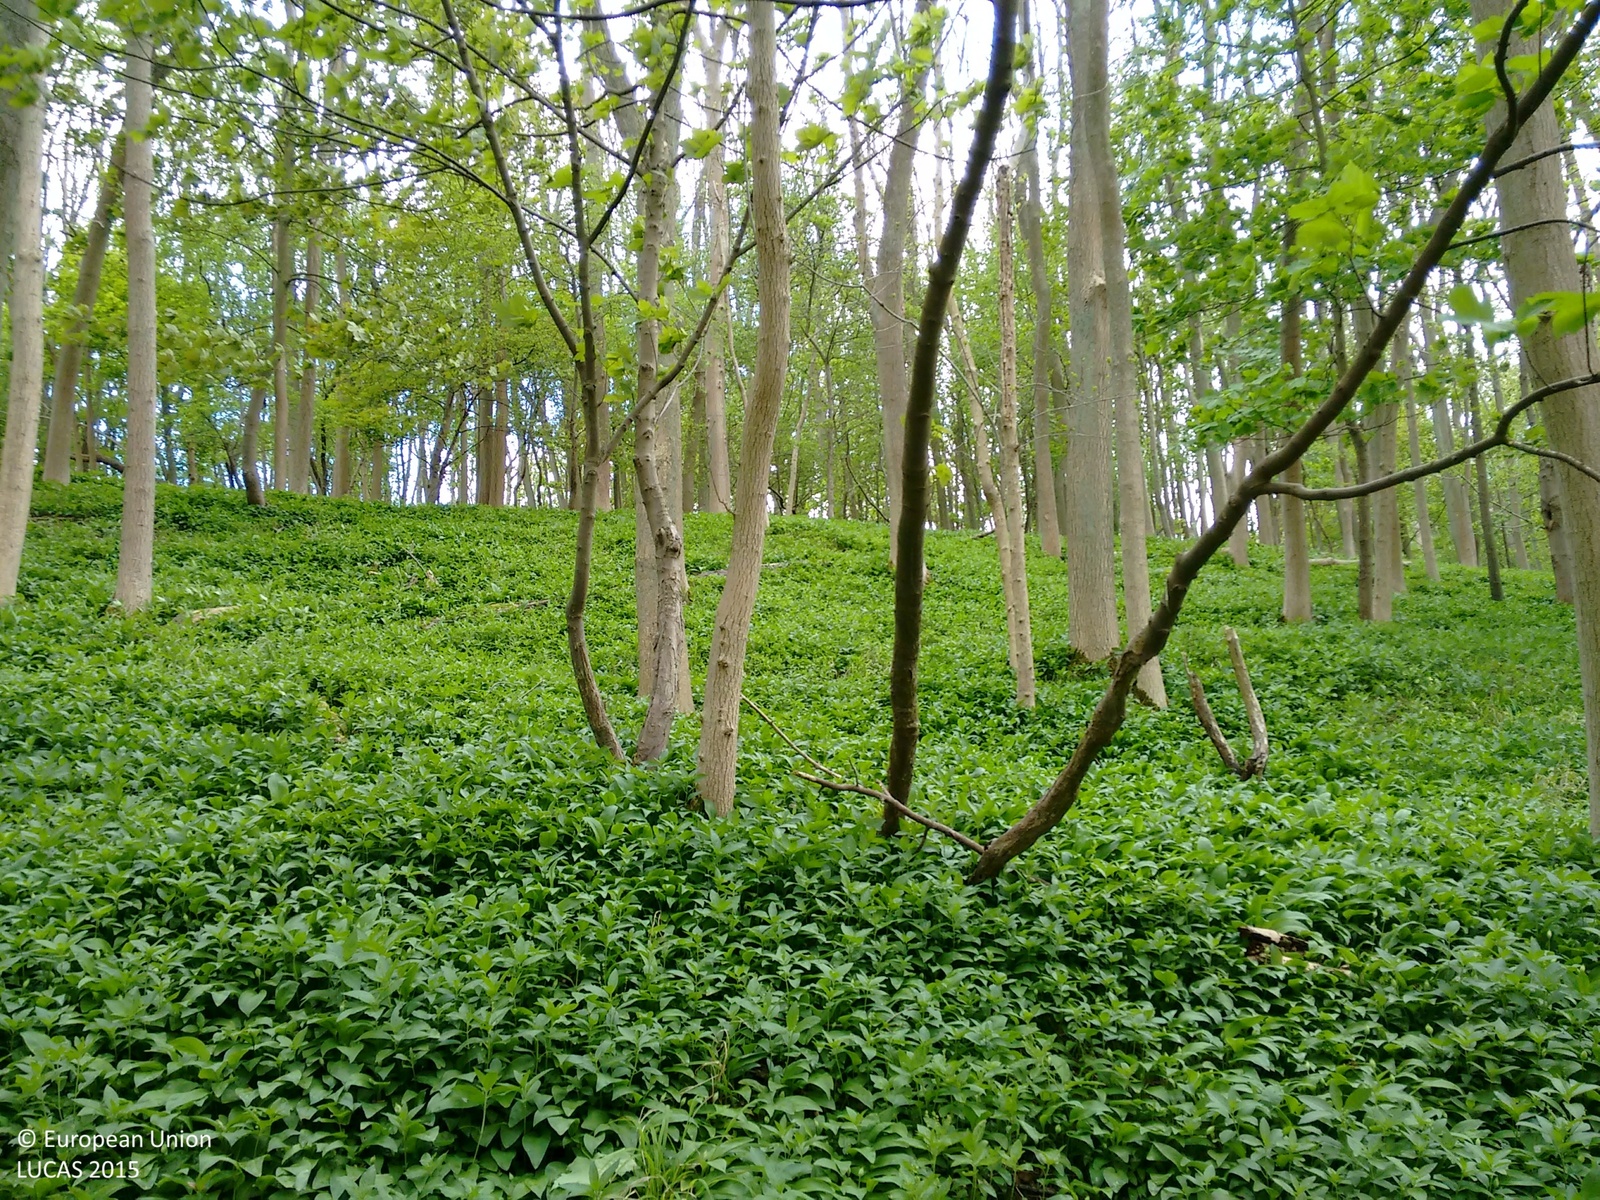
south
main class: Woodland
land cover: Broadleaved woodland
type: mesophytic deciduous forest
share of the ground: > 75 %
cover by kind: broadleaved forest trees 80 %, herbaceous plants 20 %
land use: Forestry
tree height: > 5 m
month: May
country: GB
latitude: 51.8299
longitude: -0.5887
